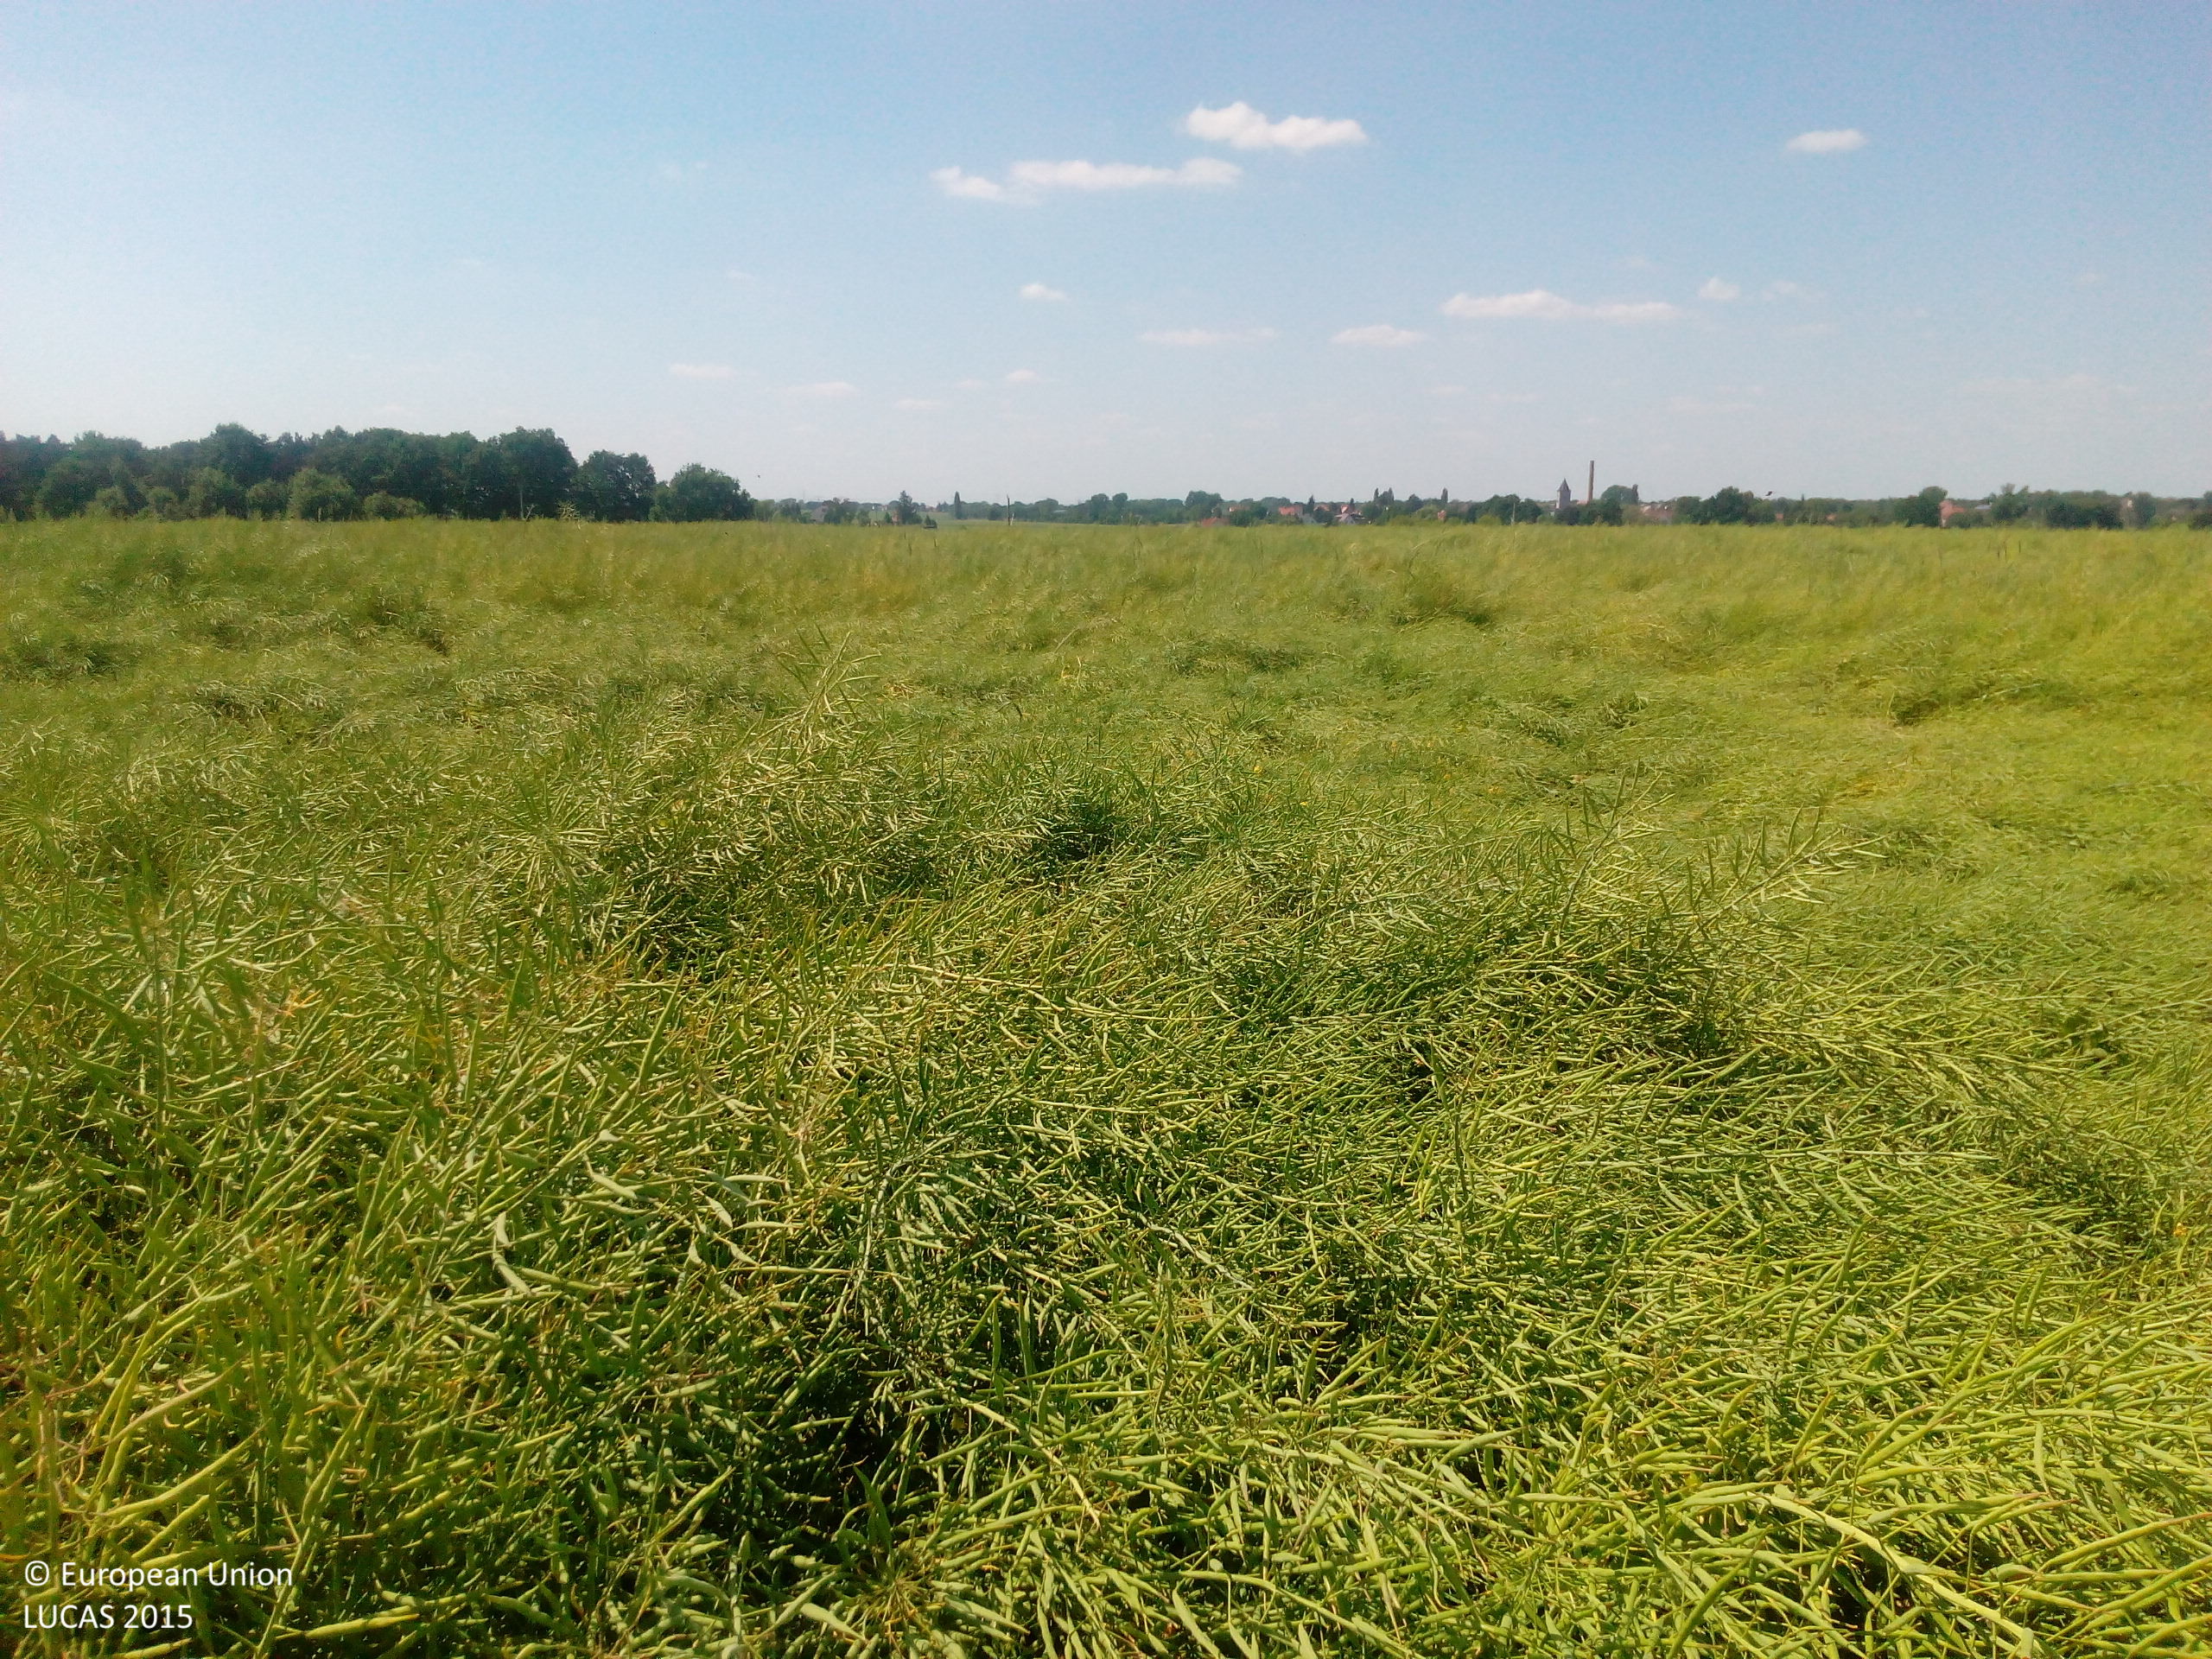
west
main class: Cropland
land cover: Rape and turnip rape
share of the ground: > 75 %
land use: Agriculture (excluding fallow land and kitchen gardens)
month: June
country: DE
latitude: 51.2820
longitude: 13.5130
